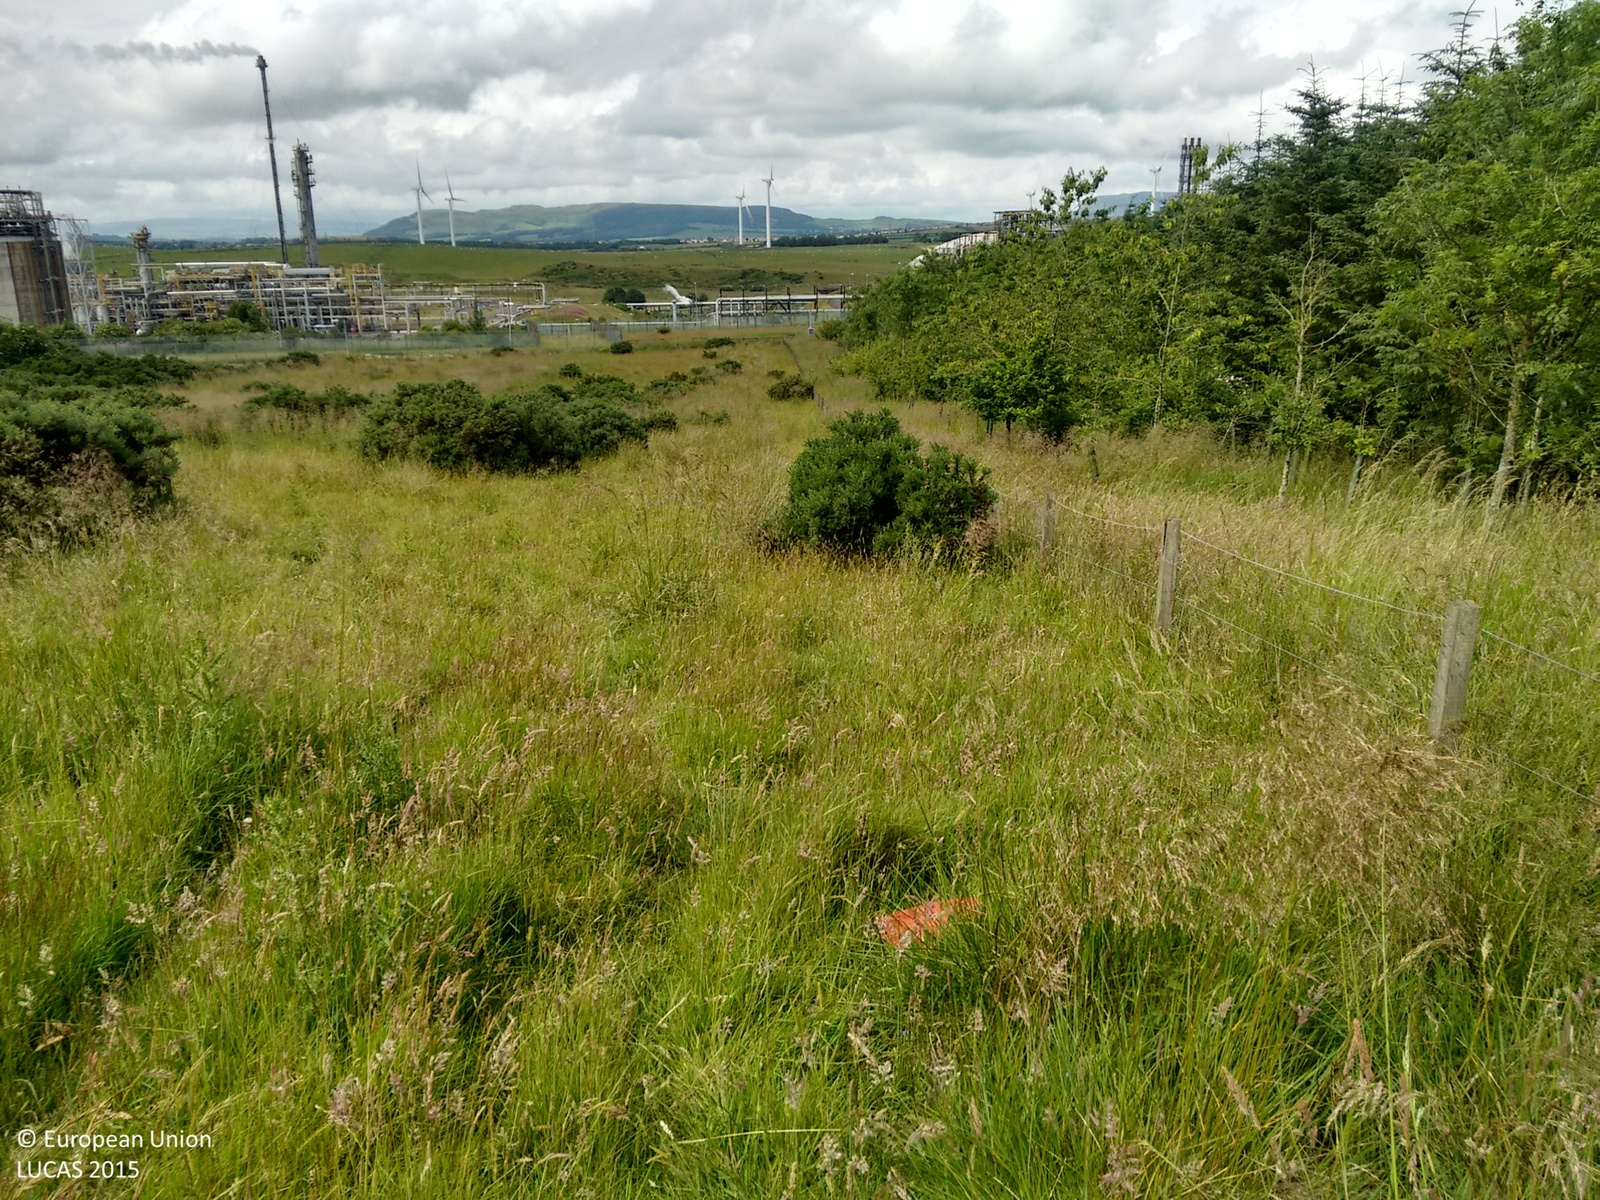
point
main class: Grassland
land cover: Grassland with sparse tree/shrub cover
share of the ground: > 75 %
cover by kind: herbaceous plants 90 %, broadleaved forest trees 5 %, shrubs 5 %
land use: Agriculture (excluding fallow land and kitchen gardens)
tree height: < 5 m
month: July
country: GB
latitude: 56.0935
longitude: -3.3016
